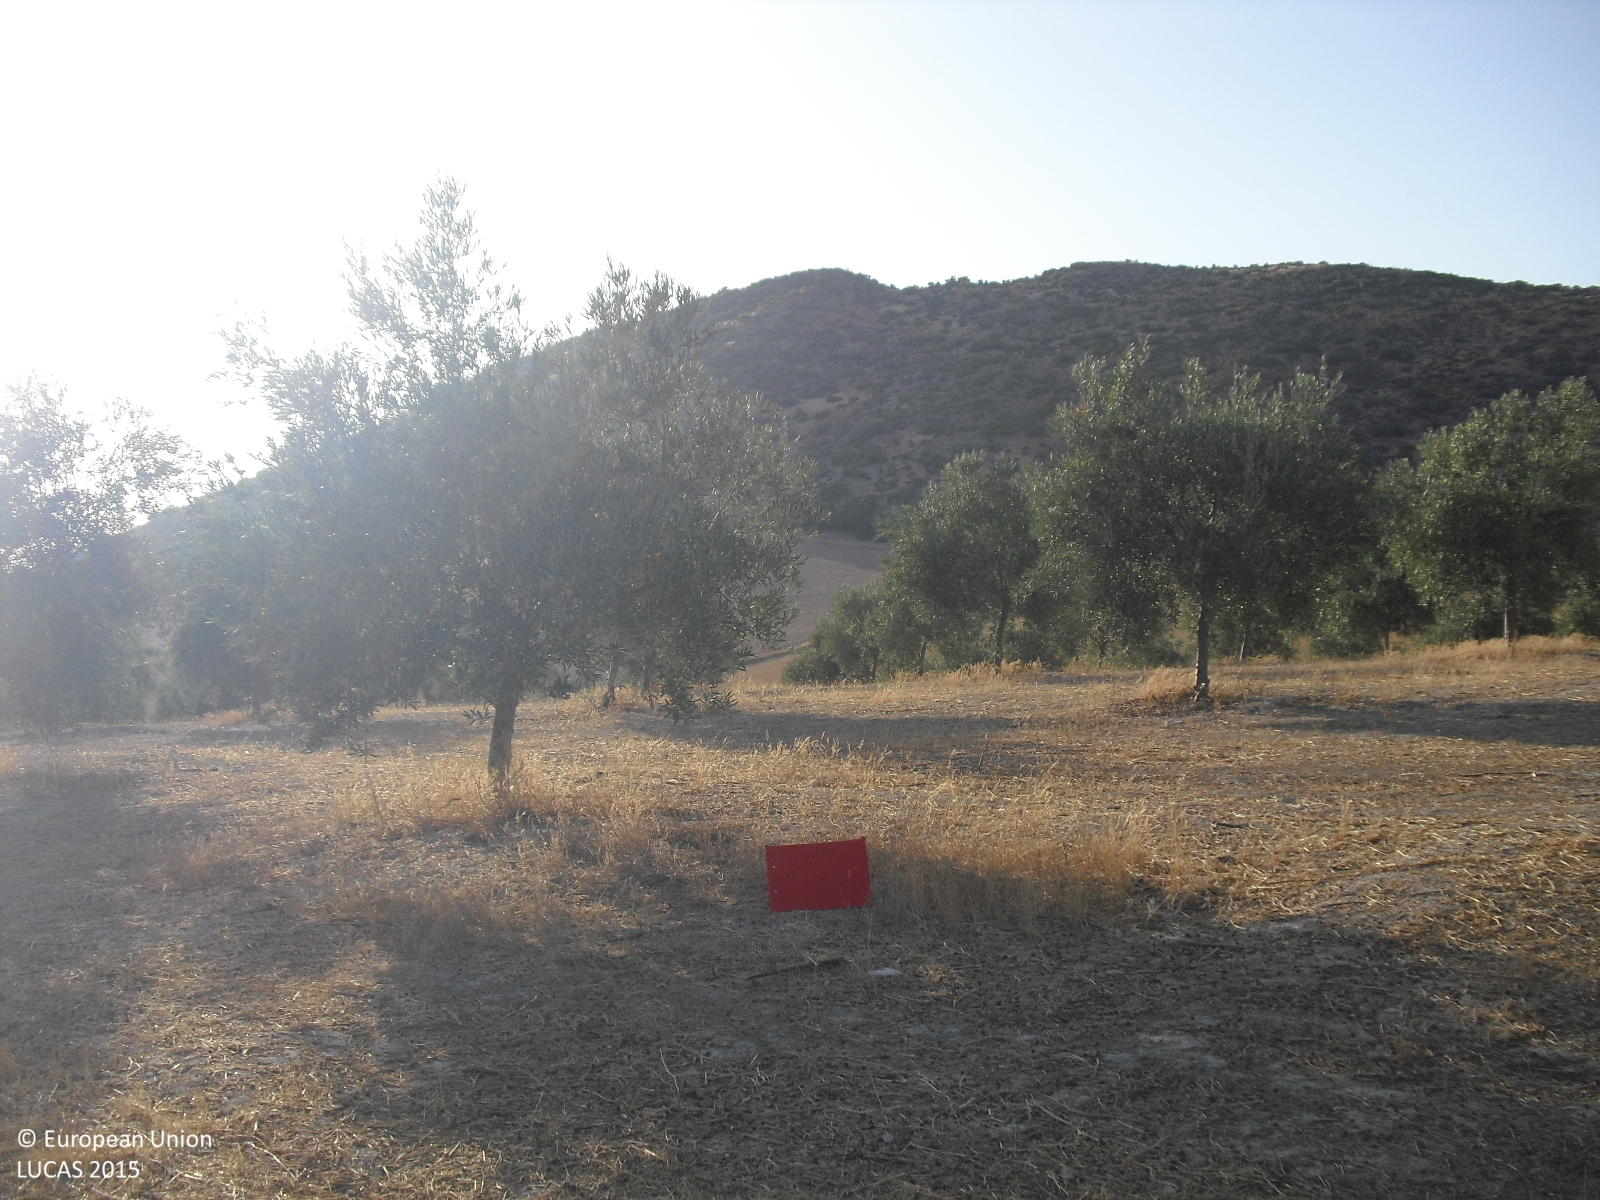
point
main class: Cropland
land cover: Olive groves
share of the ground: 25 - 50 %
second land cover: Other bare soil
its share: > 75 %
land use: Agriculture (excluding fallow land and kitchen gardens)
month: July
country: ES
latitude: 37.0764
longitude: -5.4990
